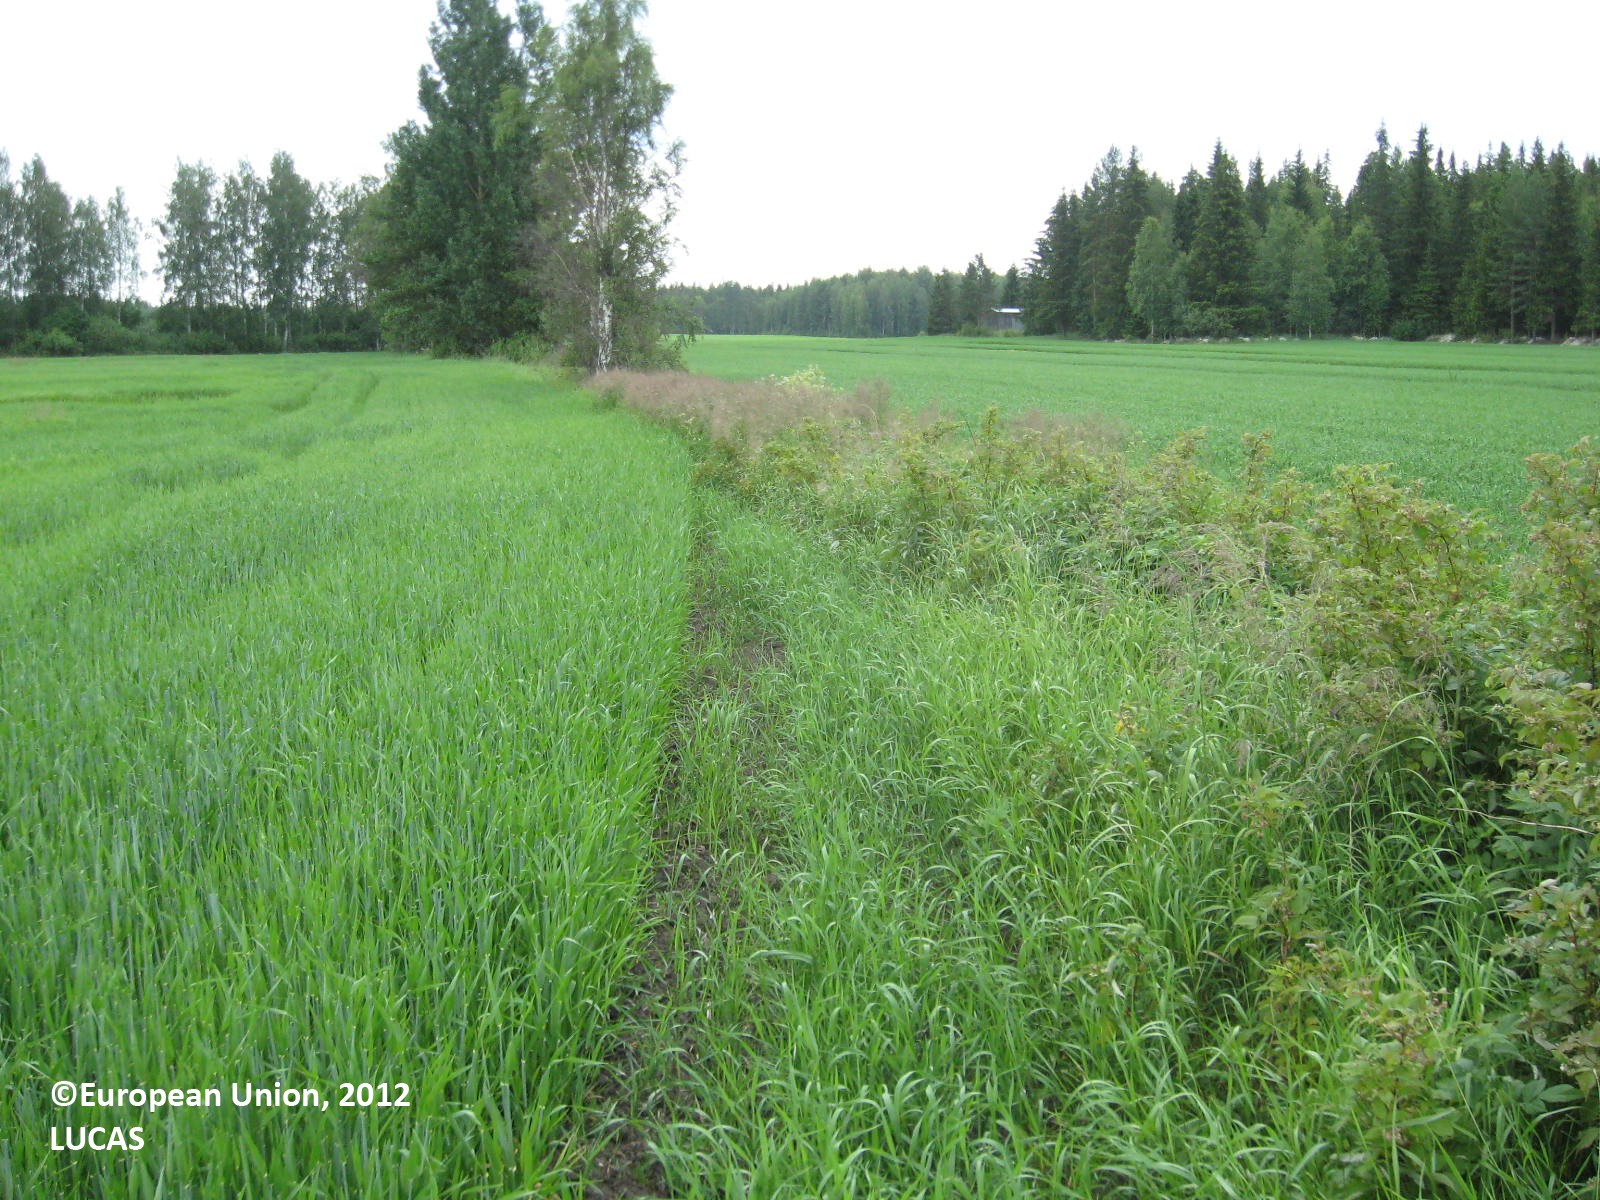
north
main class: Cropland
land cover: Barley
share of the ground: > 75 %
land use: Agriculture (excluding fallow land and kitchen gardens)
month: July
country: FI
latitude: 62.5126
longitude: 22.8985
